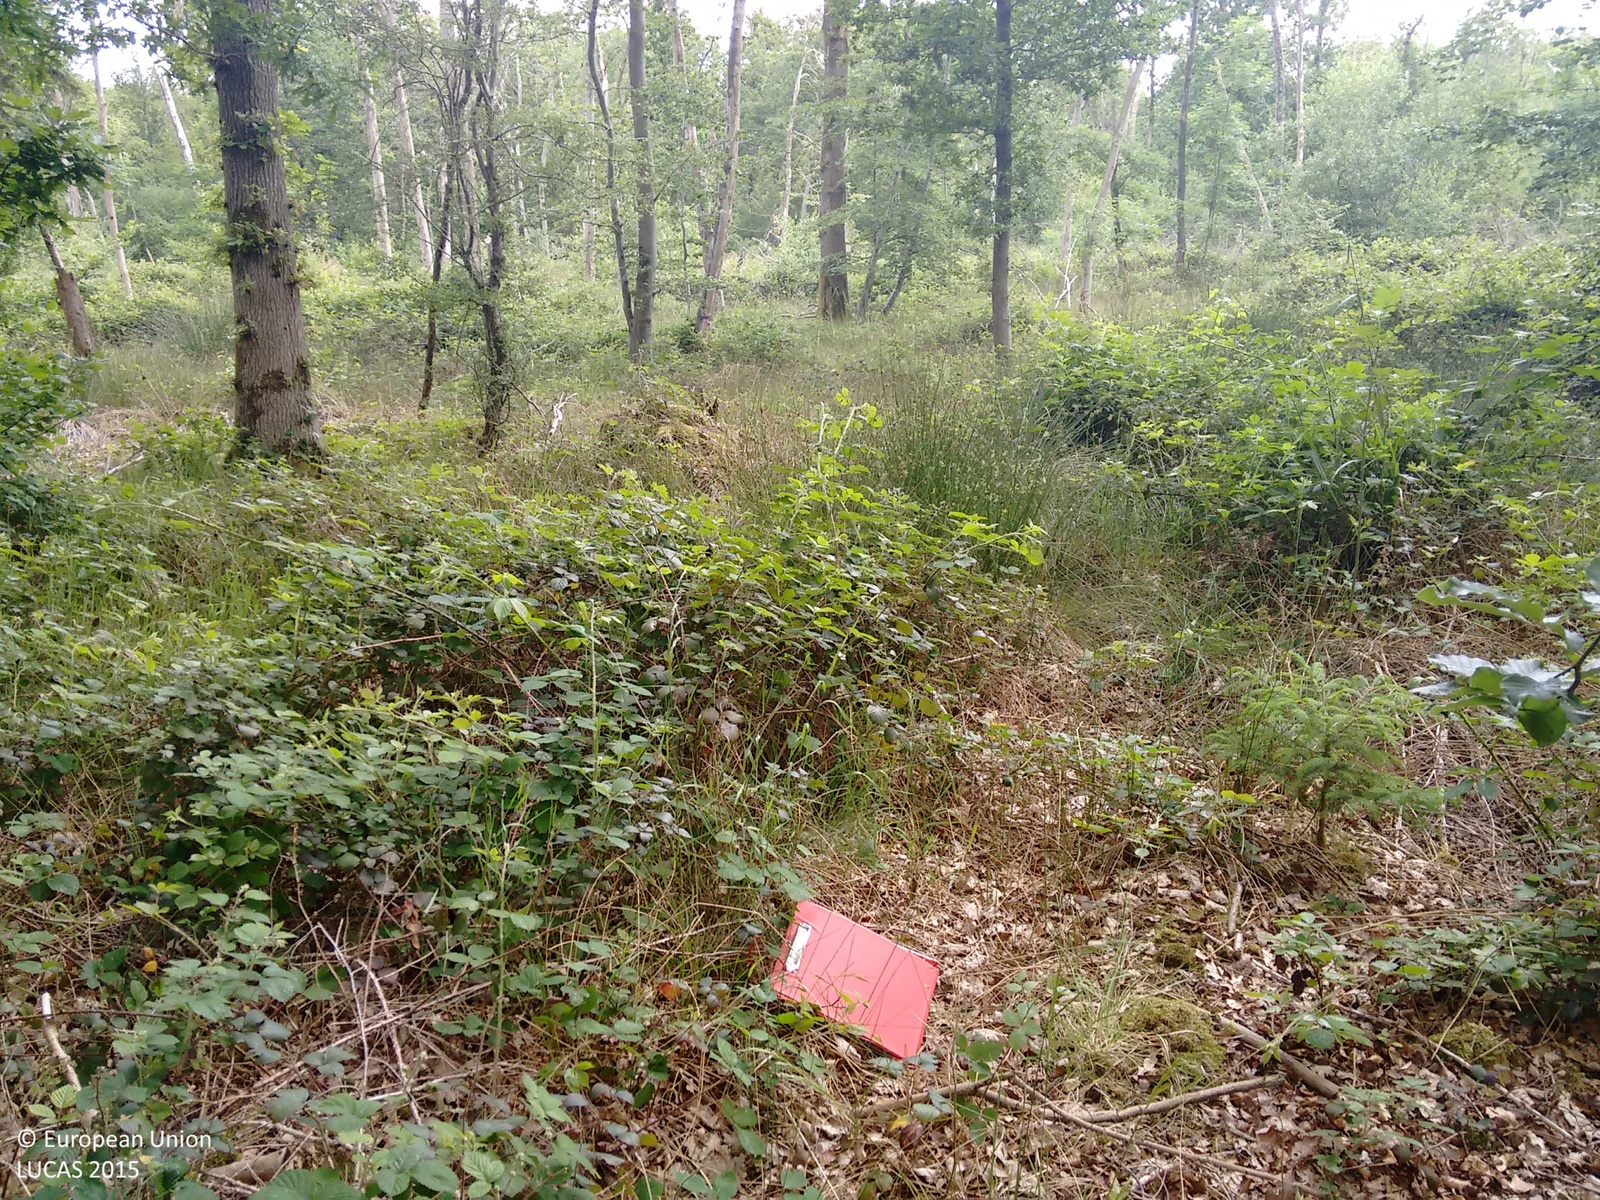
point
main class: Woodland
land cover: Broadleaved woodland
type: mesophytic deciduous forest
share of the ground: > 75 %
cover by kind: broadleaved forest trees 100 %
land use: Forestry
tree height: > 5 m
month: June
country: GB
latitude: 51.5731
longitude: -1.9322
